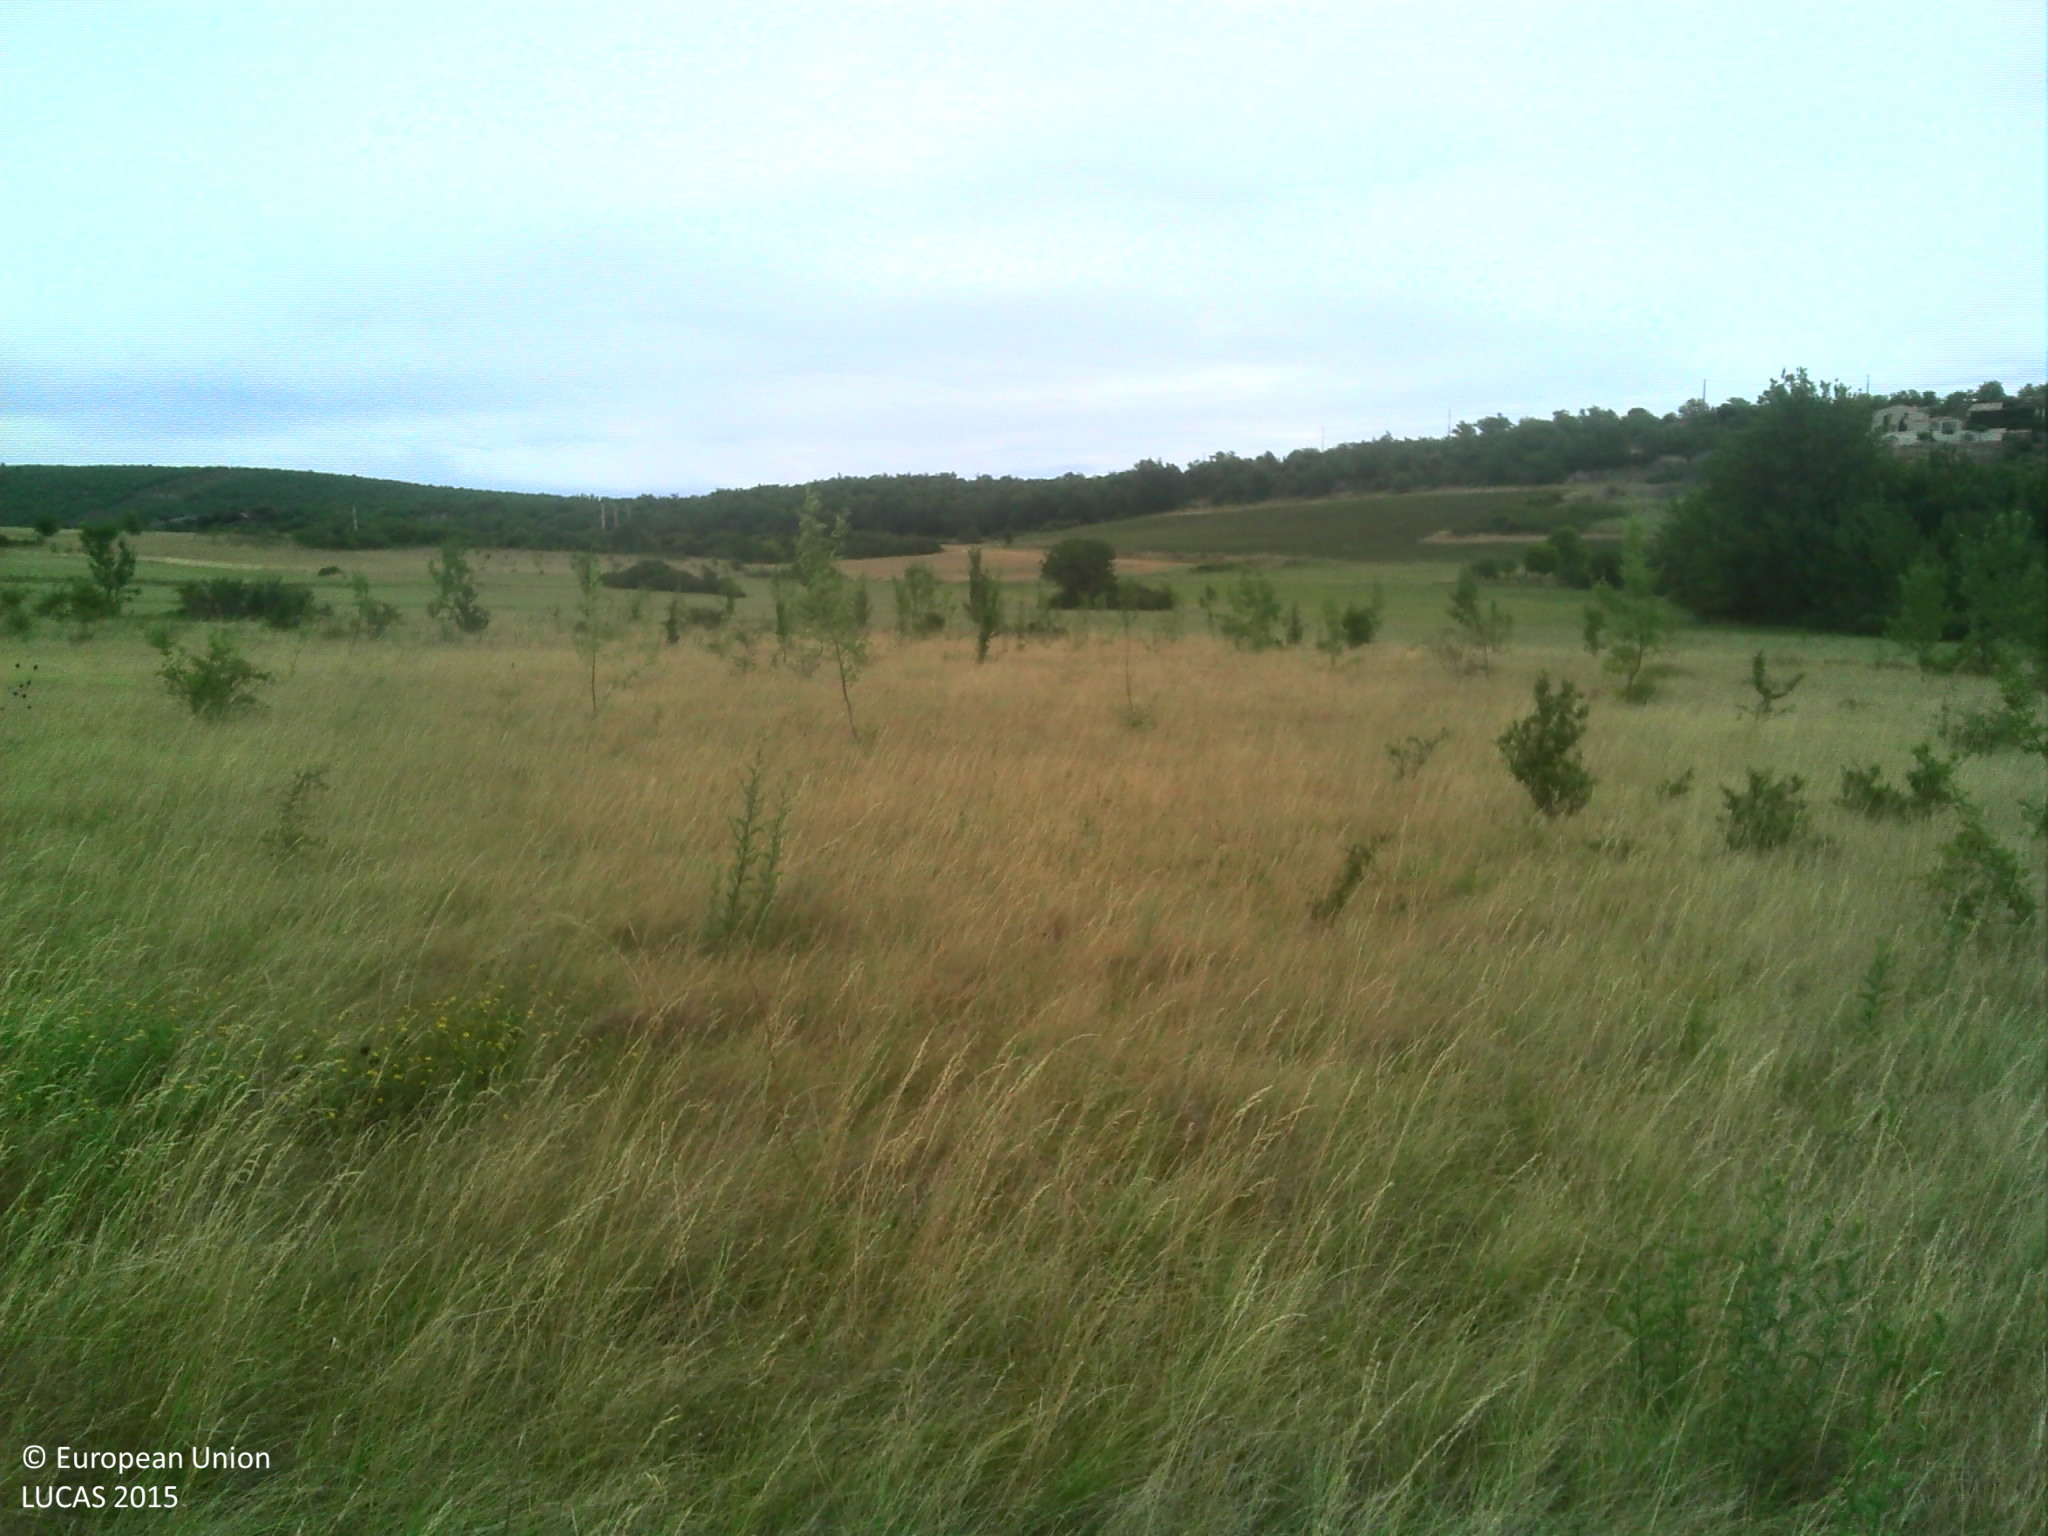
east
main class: Grassland
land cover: Grassland with sparse tree/shrub cover
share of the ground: > 75 %
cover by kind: herbaceous plants 95 %, broadleaved forest trees 5 %
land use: Semi-natural and natural areas not in use
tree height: < 5 m
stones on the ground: < 10 %
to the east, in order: Grassland with sparse tree/shrub cover; Grassland without tree/shrub cover; Single bushes/trees; Grassland without tree/shrub cover
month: July
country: FR
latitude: 43.9856
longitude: 5.5822
